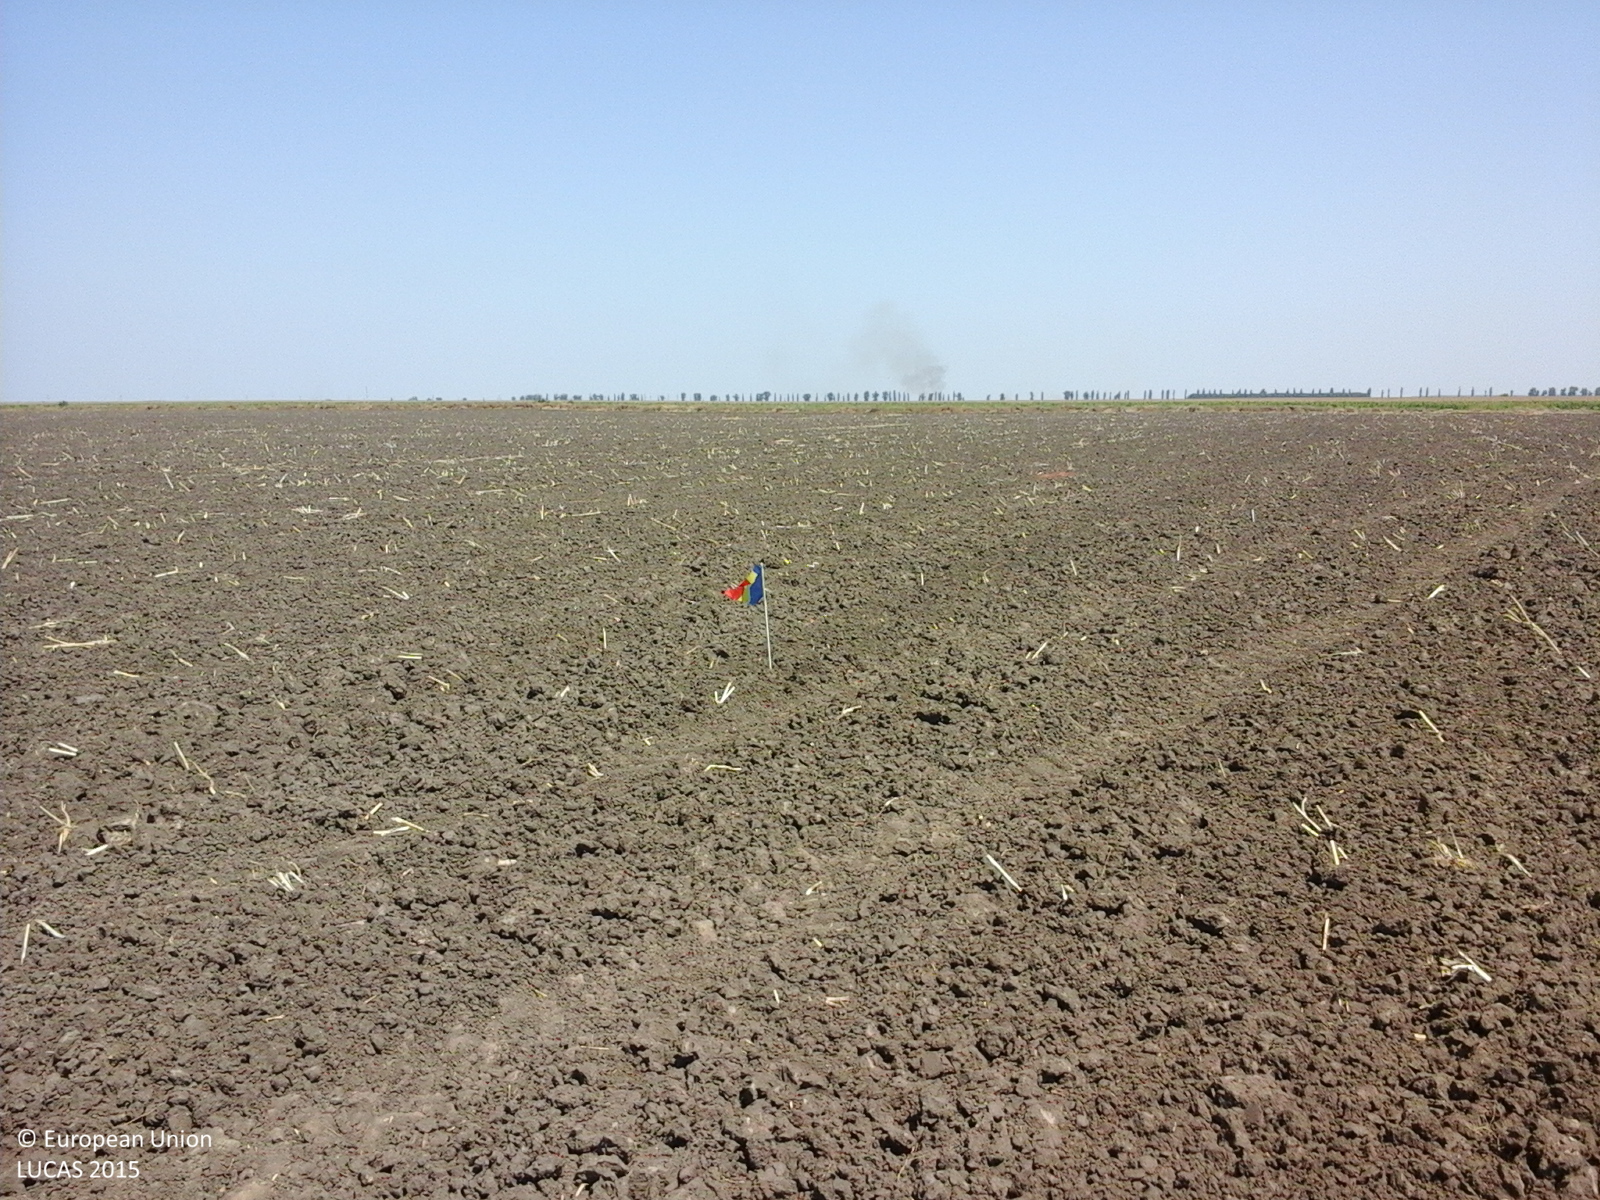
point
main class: Cropland
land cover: Rape and turnip rape
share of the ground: < 10 %
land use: Agriculture (excluding fallow land and kitchen gardens)
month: July
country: RO
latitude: 44.2965
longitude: 27.1125
